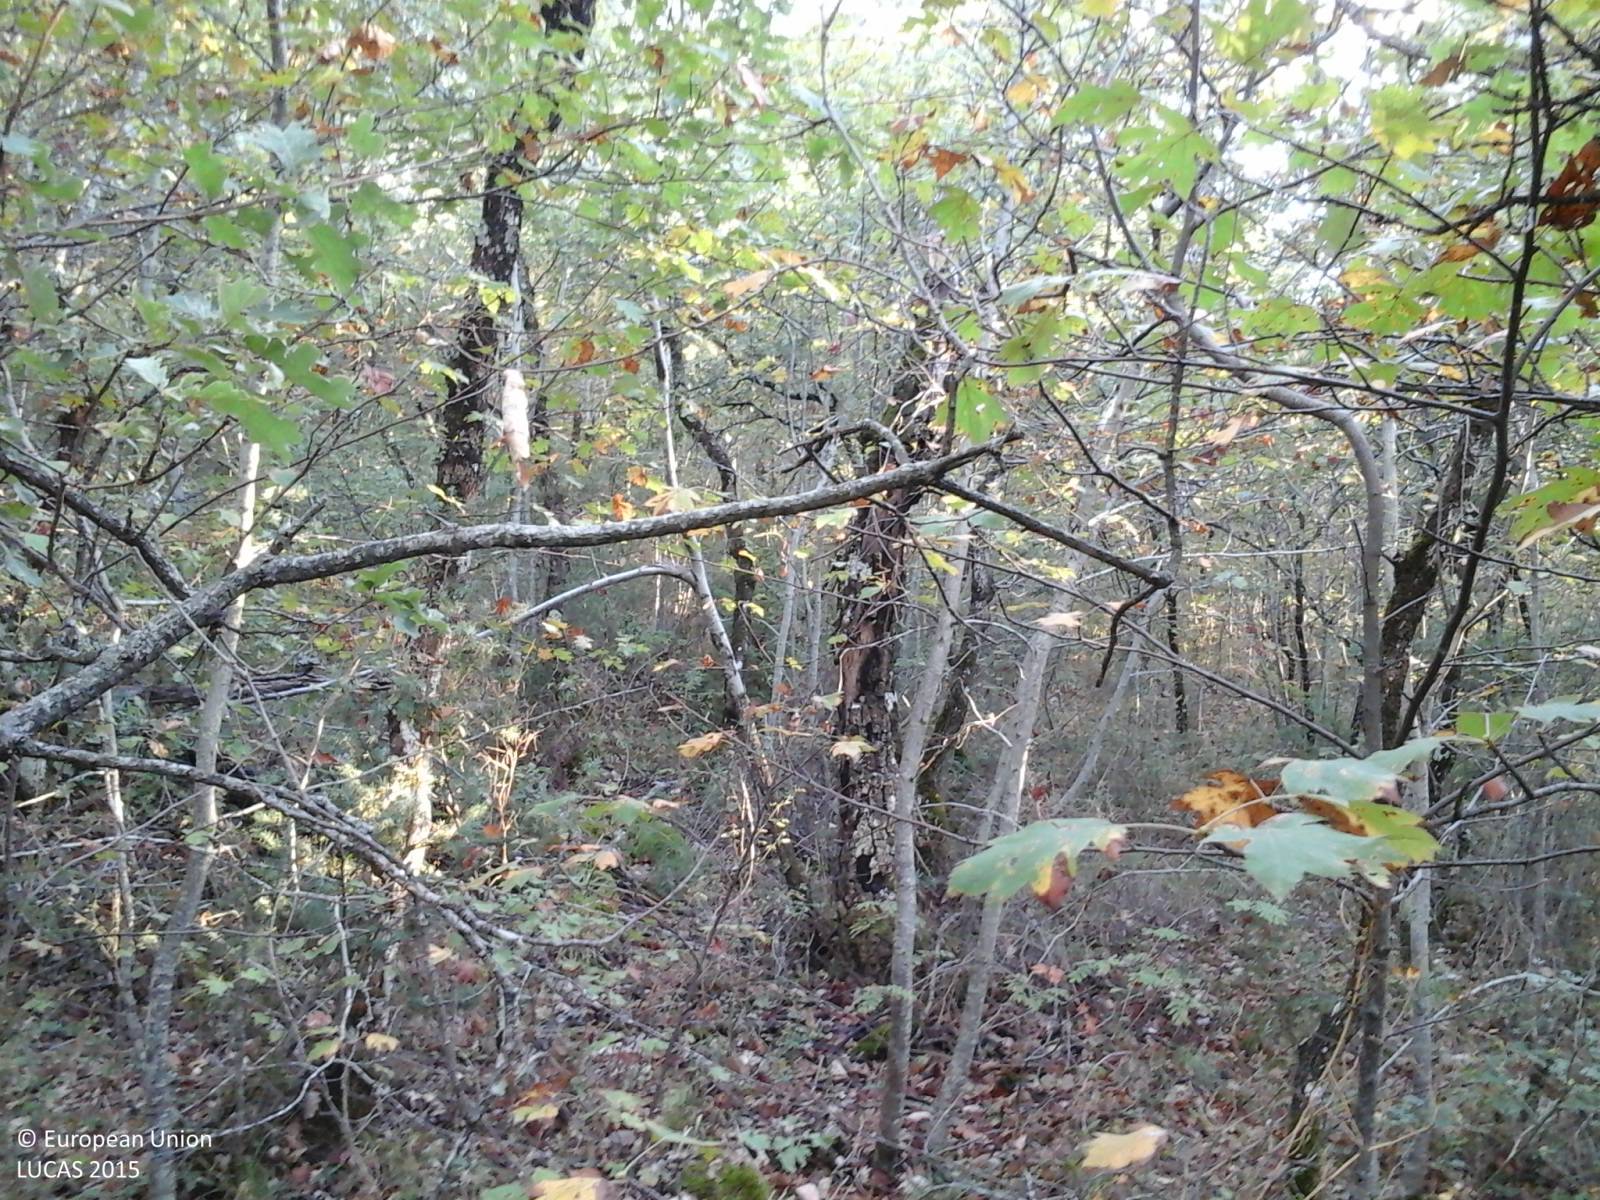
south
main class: Woodland
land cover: Broadleaved woodland
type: thermophilous deciduous forest
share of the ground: > 75 %
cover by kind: broadleaved forest trees 90 %, shrubs 10 %
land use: Forestry
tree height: > 5 m
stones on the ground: 10 - 25 %
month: September
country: IT
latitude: 42.8388
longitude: 12.5493
